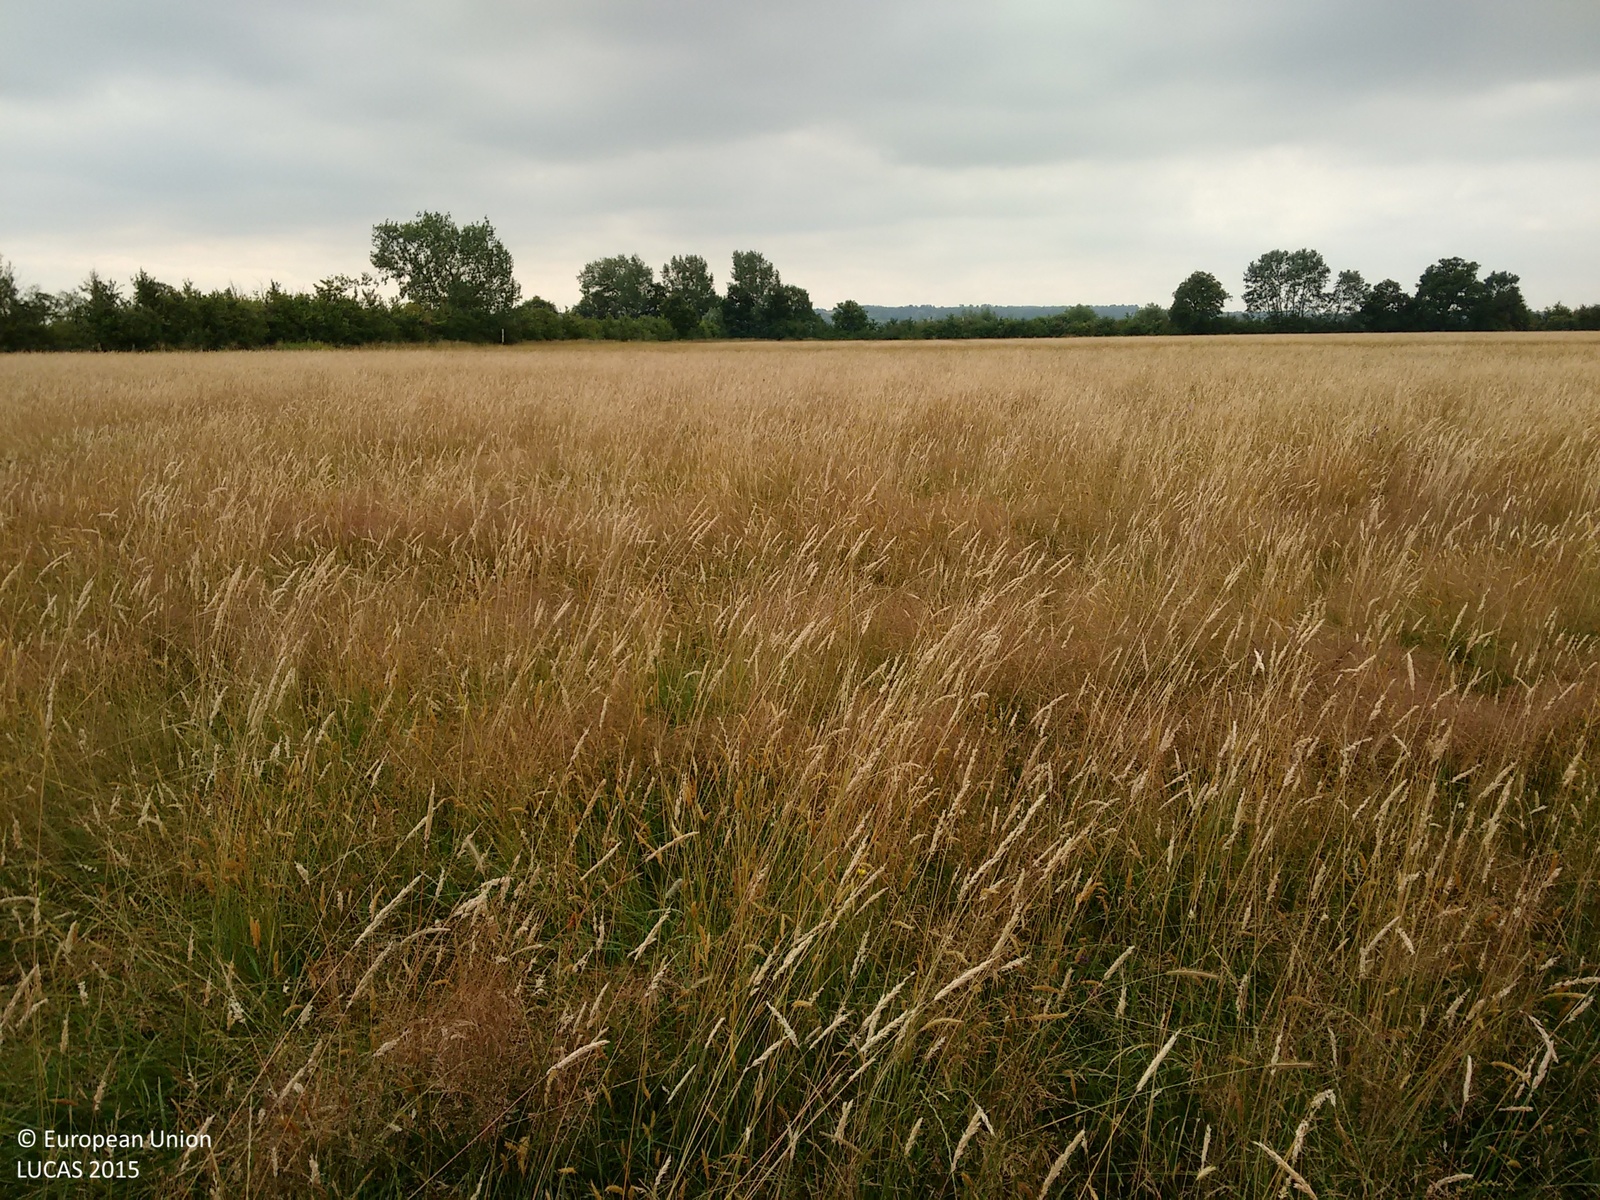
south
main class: Grassland
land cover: Grassland without tree/shrub cover
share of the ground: > 75 %
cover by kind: herbaceous plants 100 %
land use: Agriculture (excluding fallow land and kitchen gardens)
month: July
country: GB
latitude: 51.8297
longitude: -1.1764
